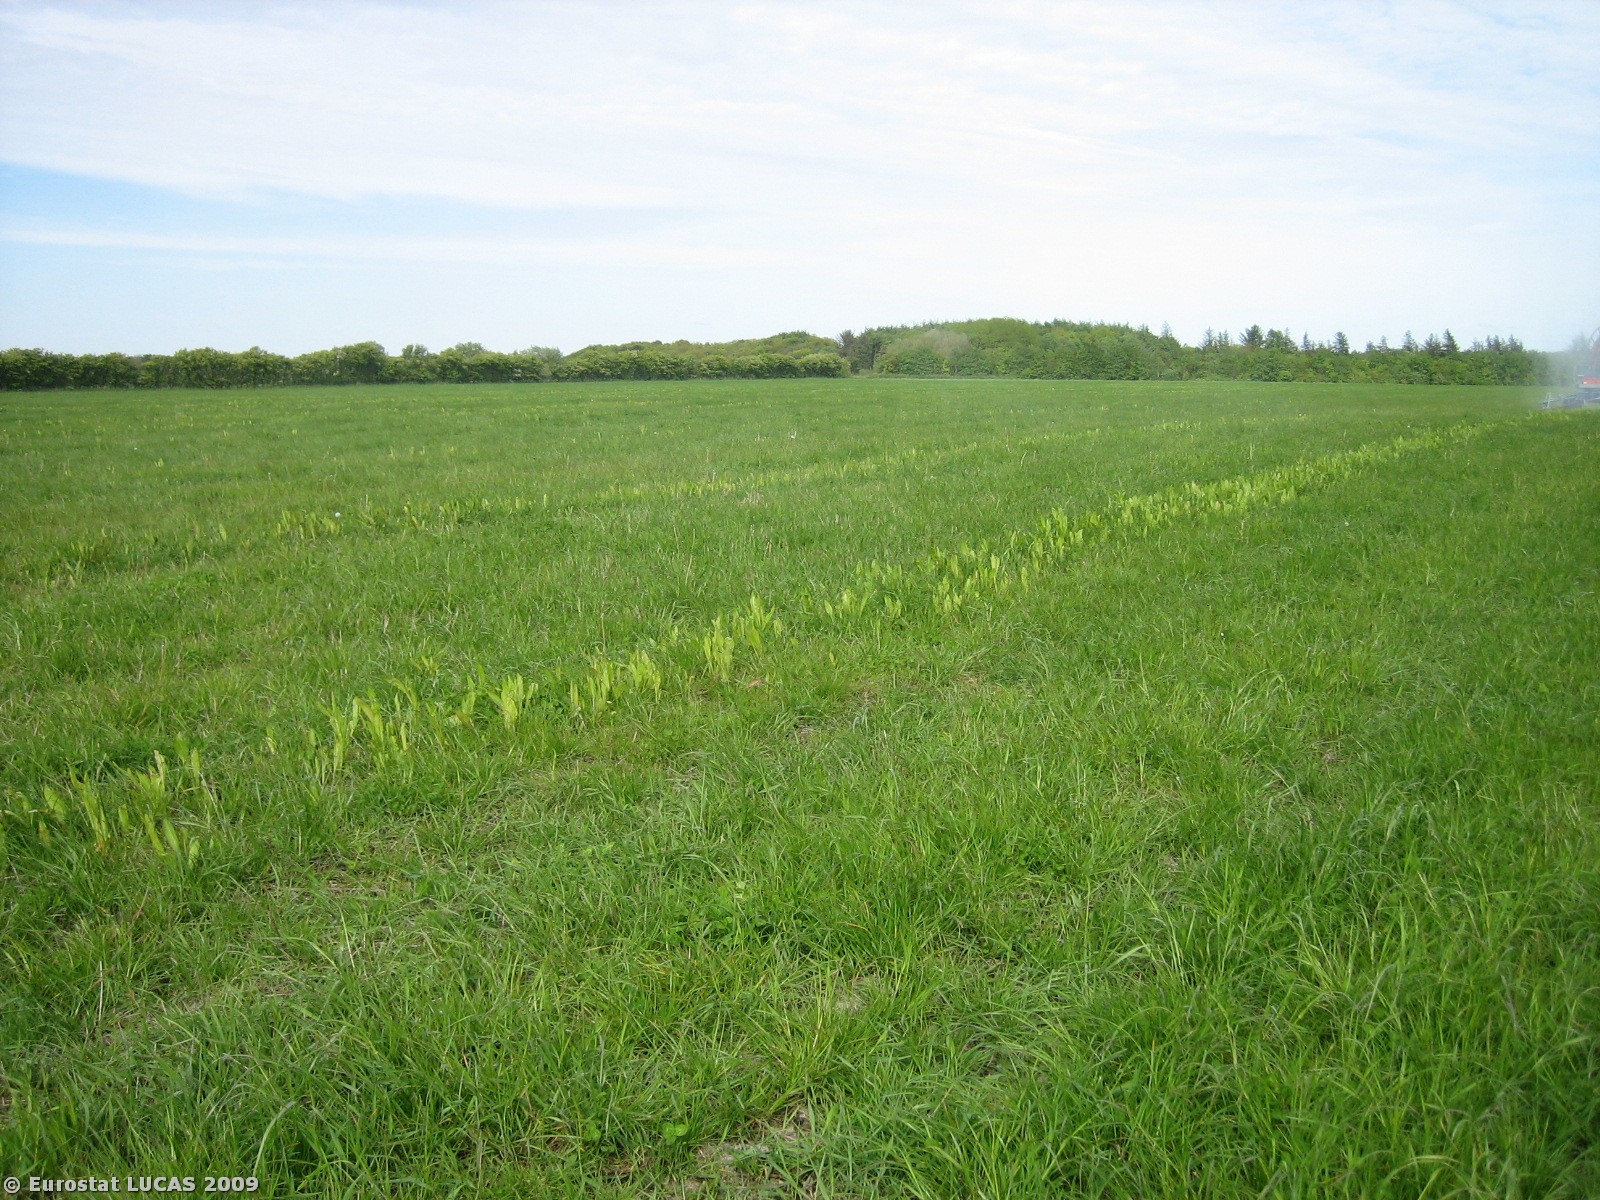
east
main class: Grassland
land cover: Grassland without tree/shrub cover
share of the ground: > 75 %
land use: Agriculture (excluding fallow land and kitchen gardens)
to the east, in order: Grassland without tree/shrub cover
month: May
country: DK
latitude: 56.0341
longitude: 8.4128
